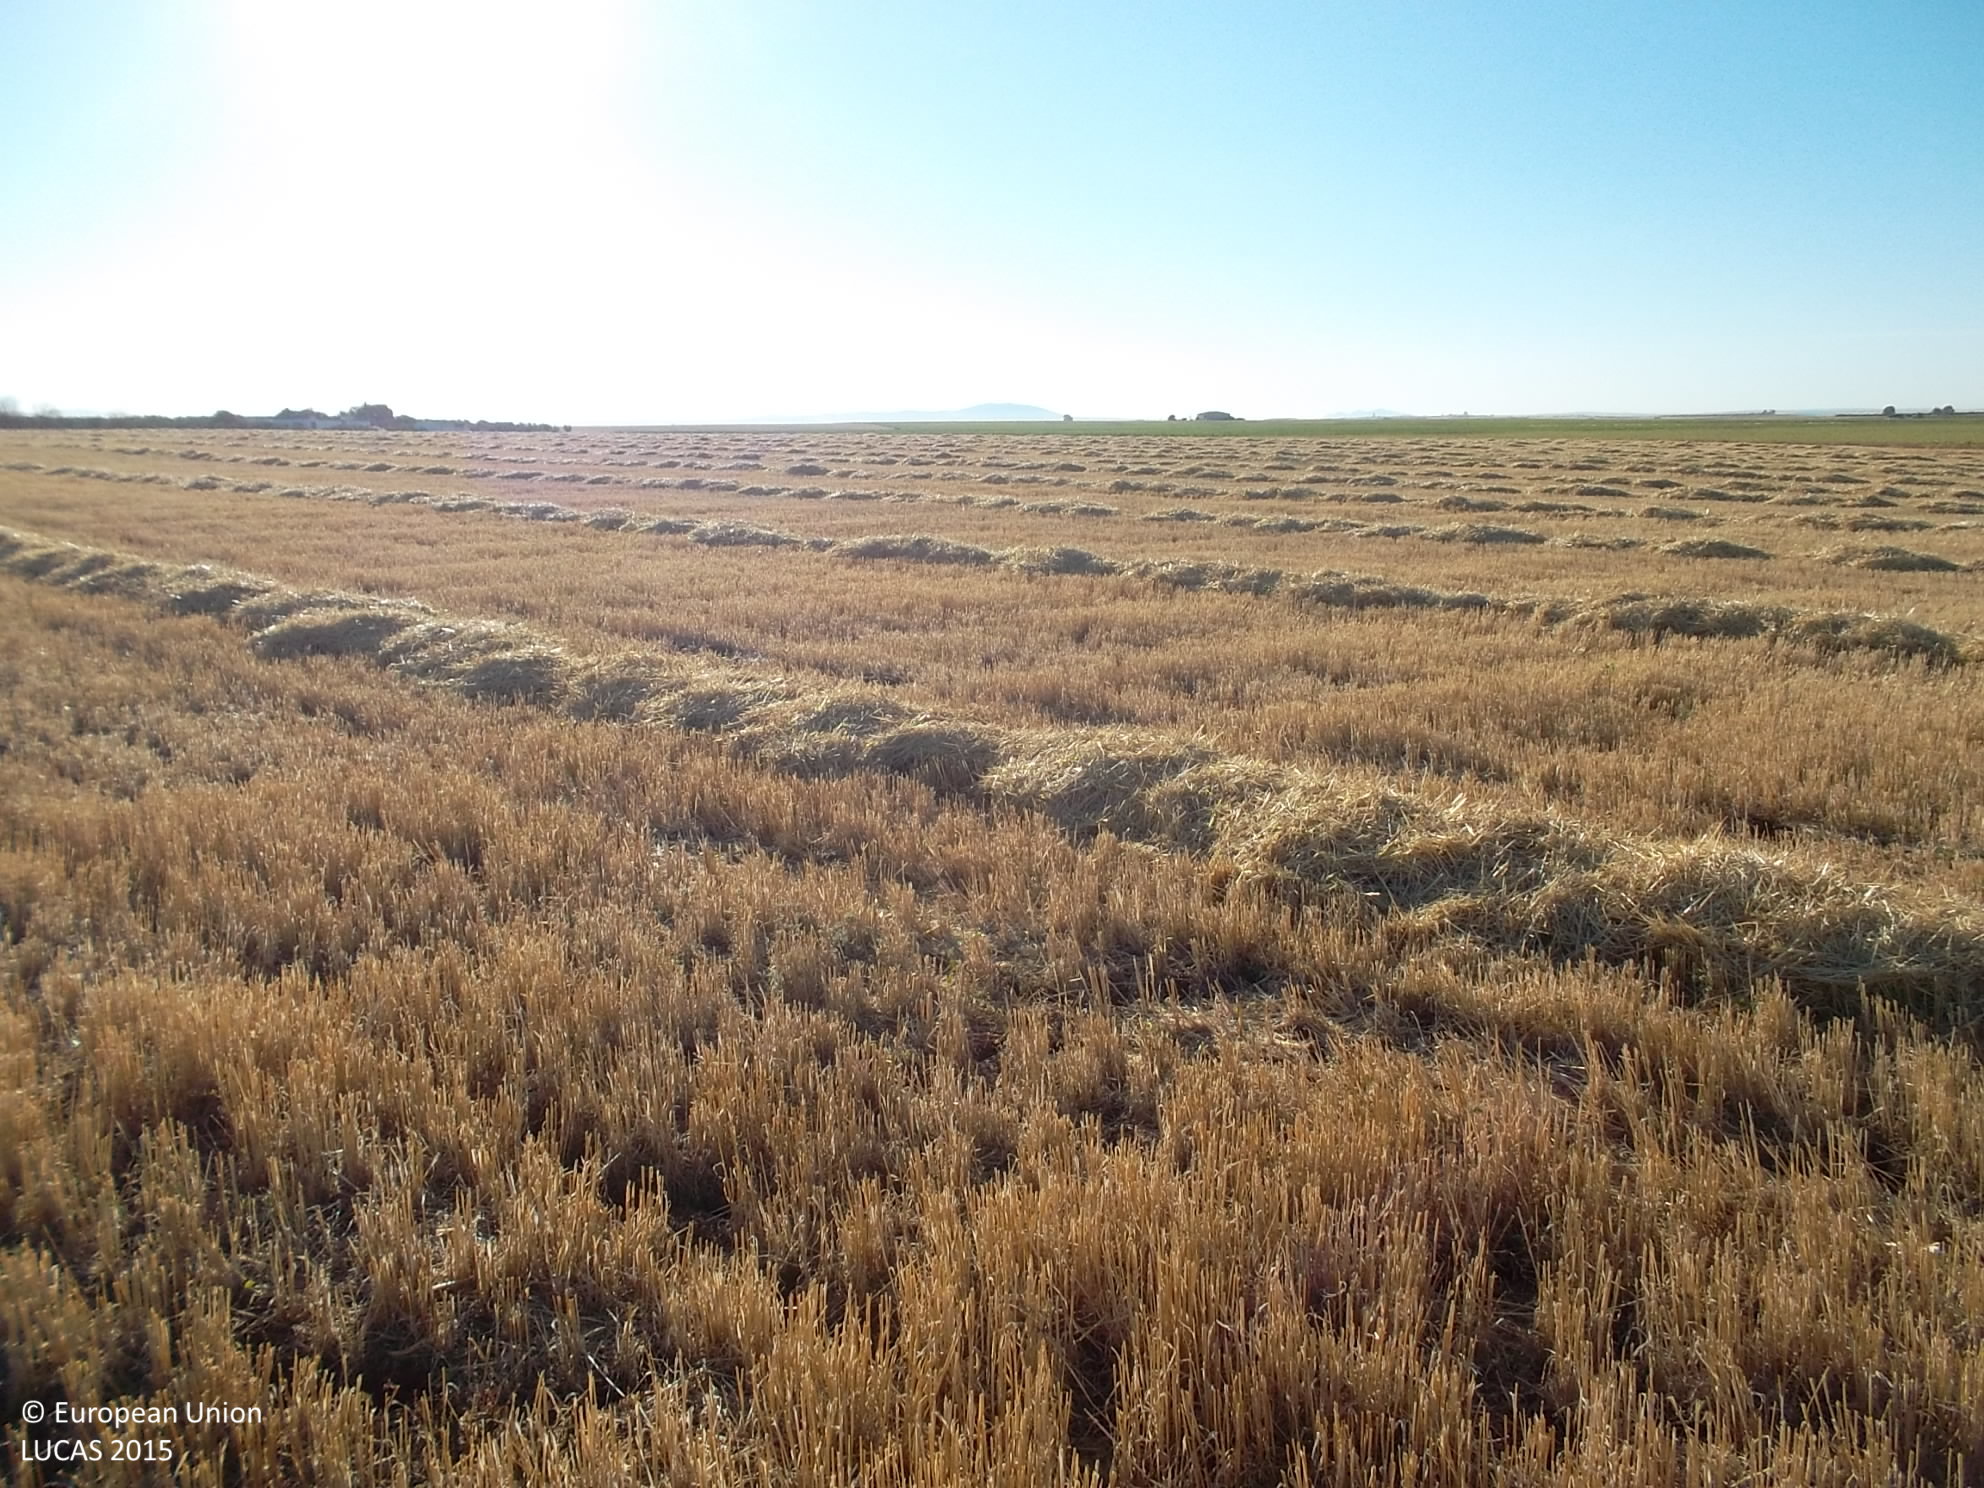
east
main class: Cropland
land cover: Barley
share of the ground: < 10 %
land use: Agriculture (excluding fallow land and kitchen gardens)
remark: Harvested field
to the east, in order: Barley; Grass margins; Tracks; Grass margins; Sunflower
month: July
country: ES
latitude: 38.3325
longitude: -5.6970
